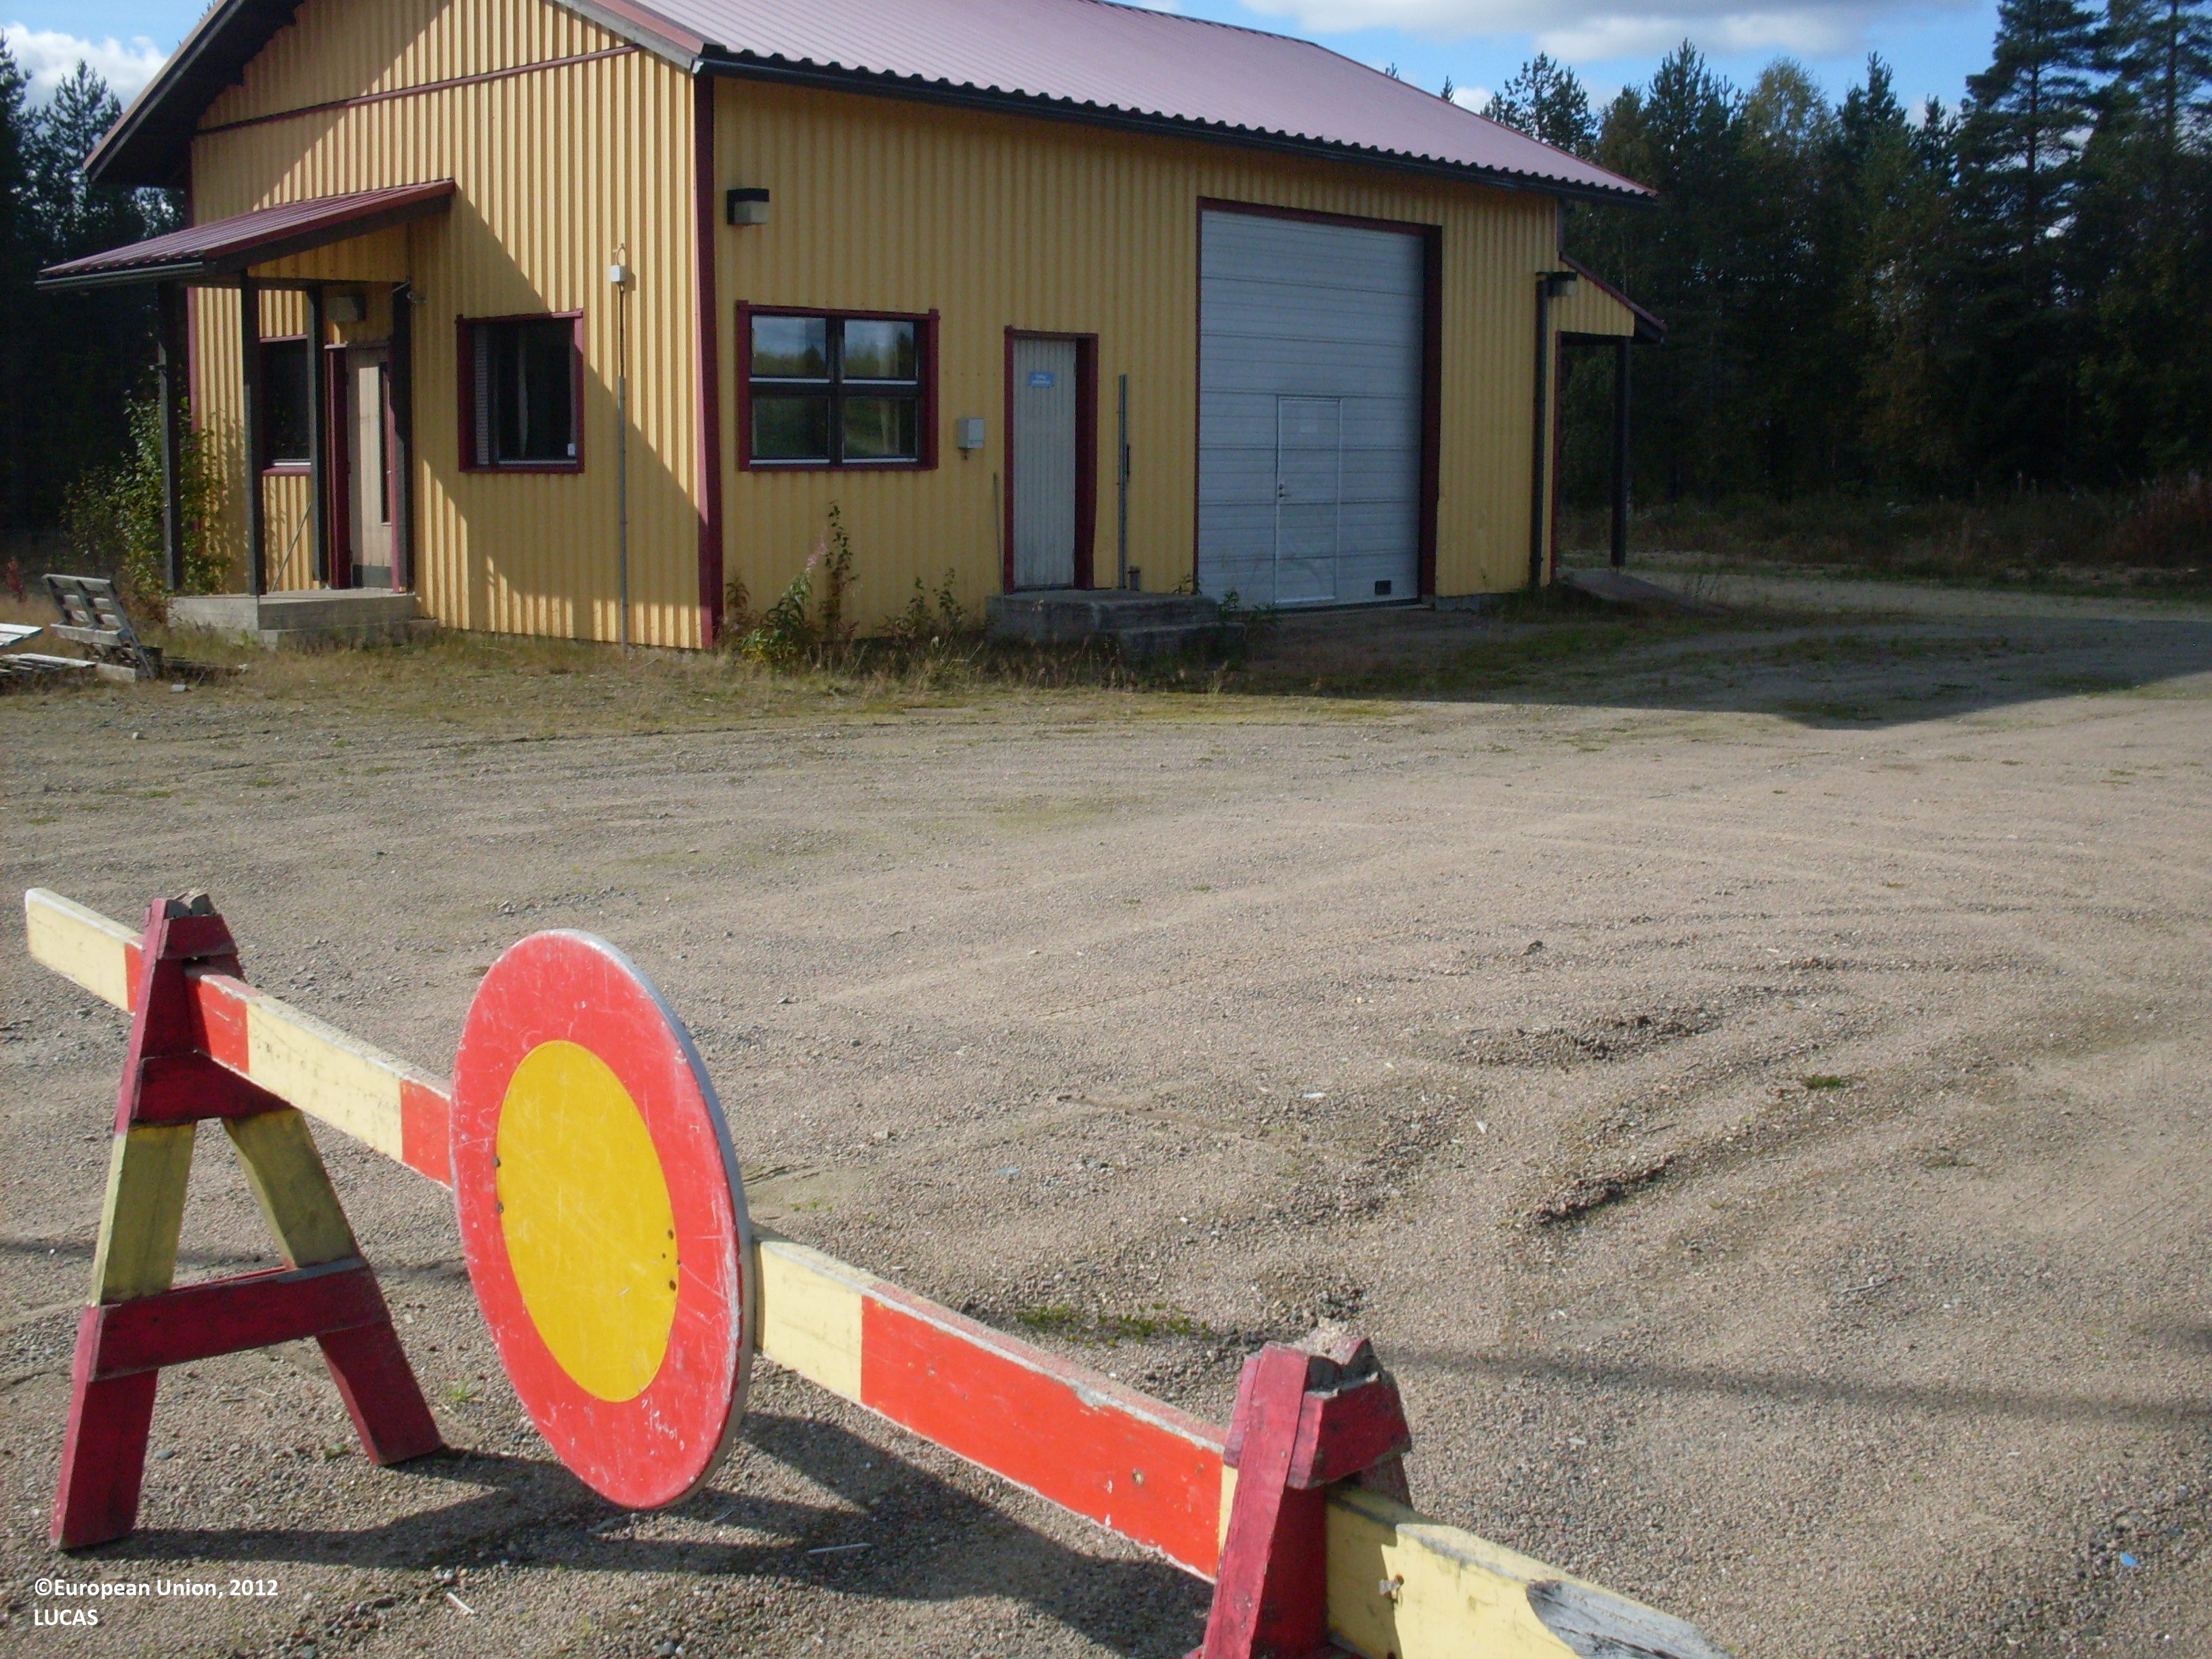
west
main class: Grassland
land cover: Grassland without tree/shrub cover
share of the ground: > 75 %
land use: Abandoned areas
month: September
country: FI
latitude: 64.0470
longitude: 29.3635
